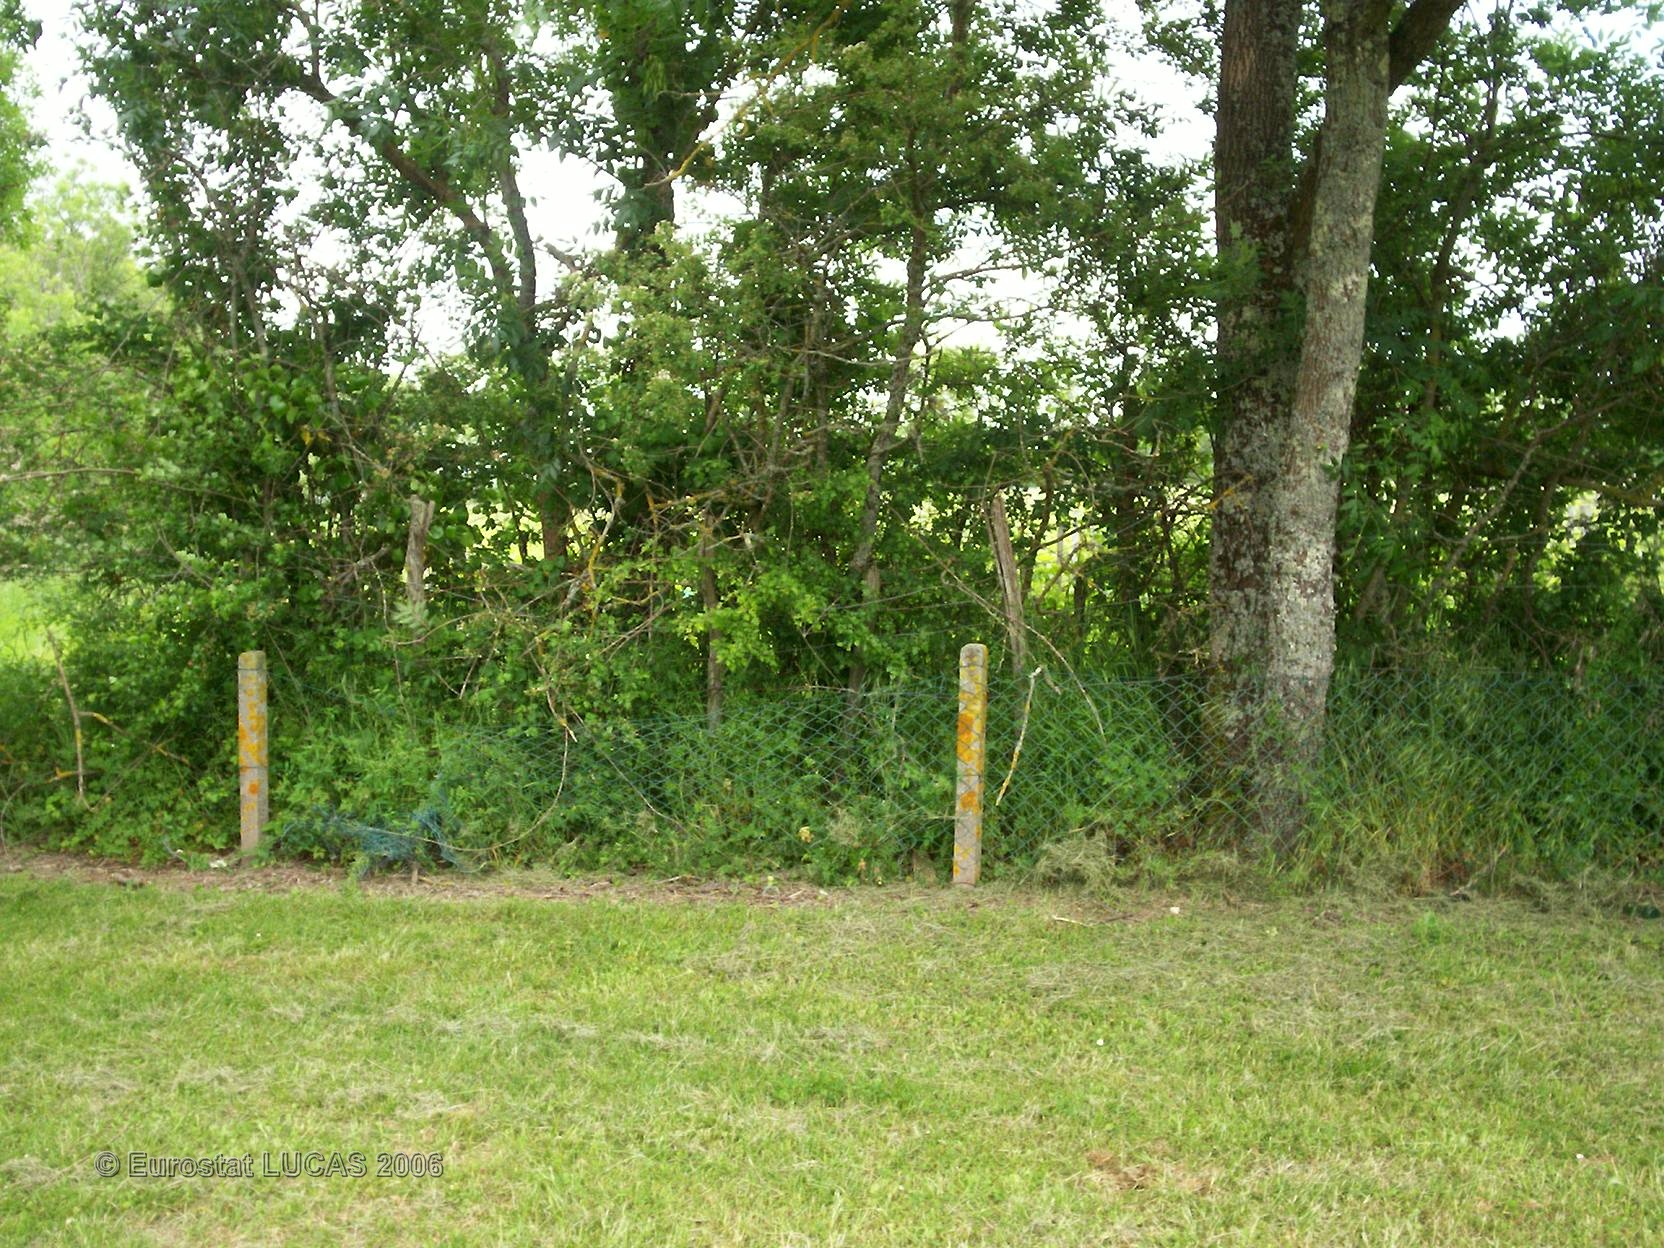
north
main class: Cropland
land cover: Other fruit trees and berries
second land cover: Bare land
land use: Agriculture (excluding fallow land and kitchen gardens)
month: June
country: FR
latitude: 45.1442
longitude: -0.6660
